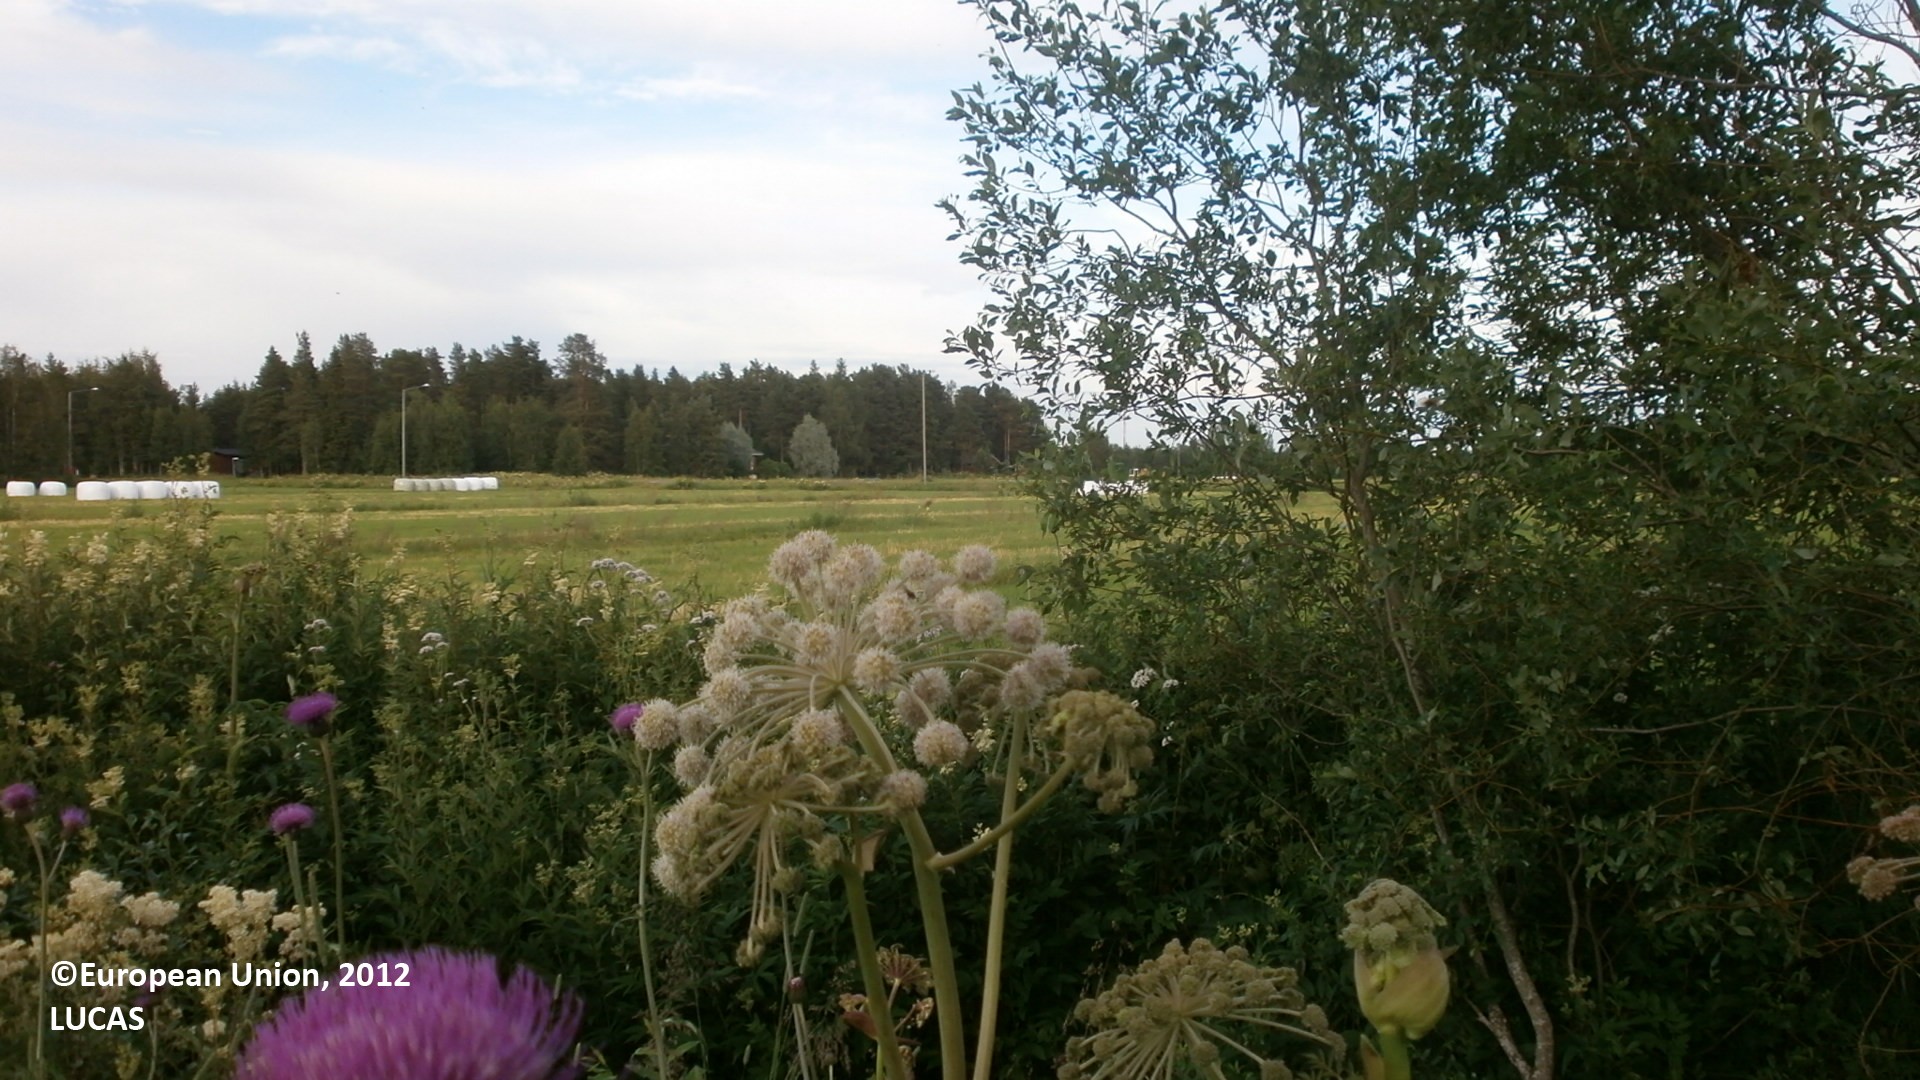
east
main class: Grassland
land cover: Grassland without tree/shrub cover
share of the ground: > 75 %
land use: Agriculture (excluding fallow land and kitchen gardens)
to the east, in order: Grassland without tree/shrub cover; Ditches and canals; Shruby margins; Temporary grasslands; Shruby margins; Ditches and canals; Shruby margins; Temporary grasslands; Shruby margins; Ditches and canals; Shruby margins; Temporary grasslands; Ditches and canals; Temporary grasslands; Ditches and canals; Shruby margins; Electric lines; Shruby margins; Paved roads, cycling and walking lanes; Shruby margins; Ditches and canals; Shruby margins; Barley; Shruby margins; Potatoes; Grassland without tree/shrub cover
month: July
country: FI
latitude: 64.4535
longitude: 24.2178
